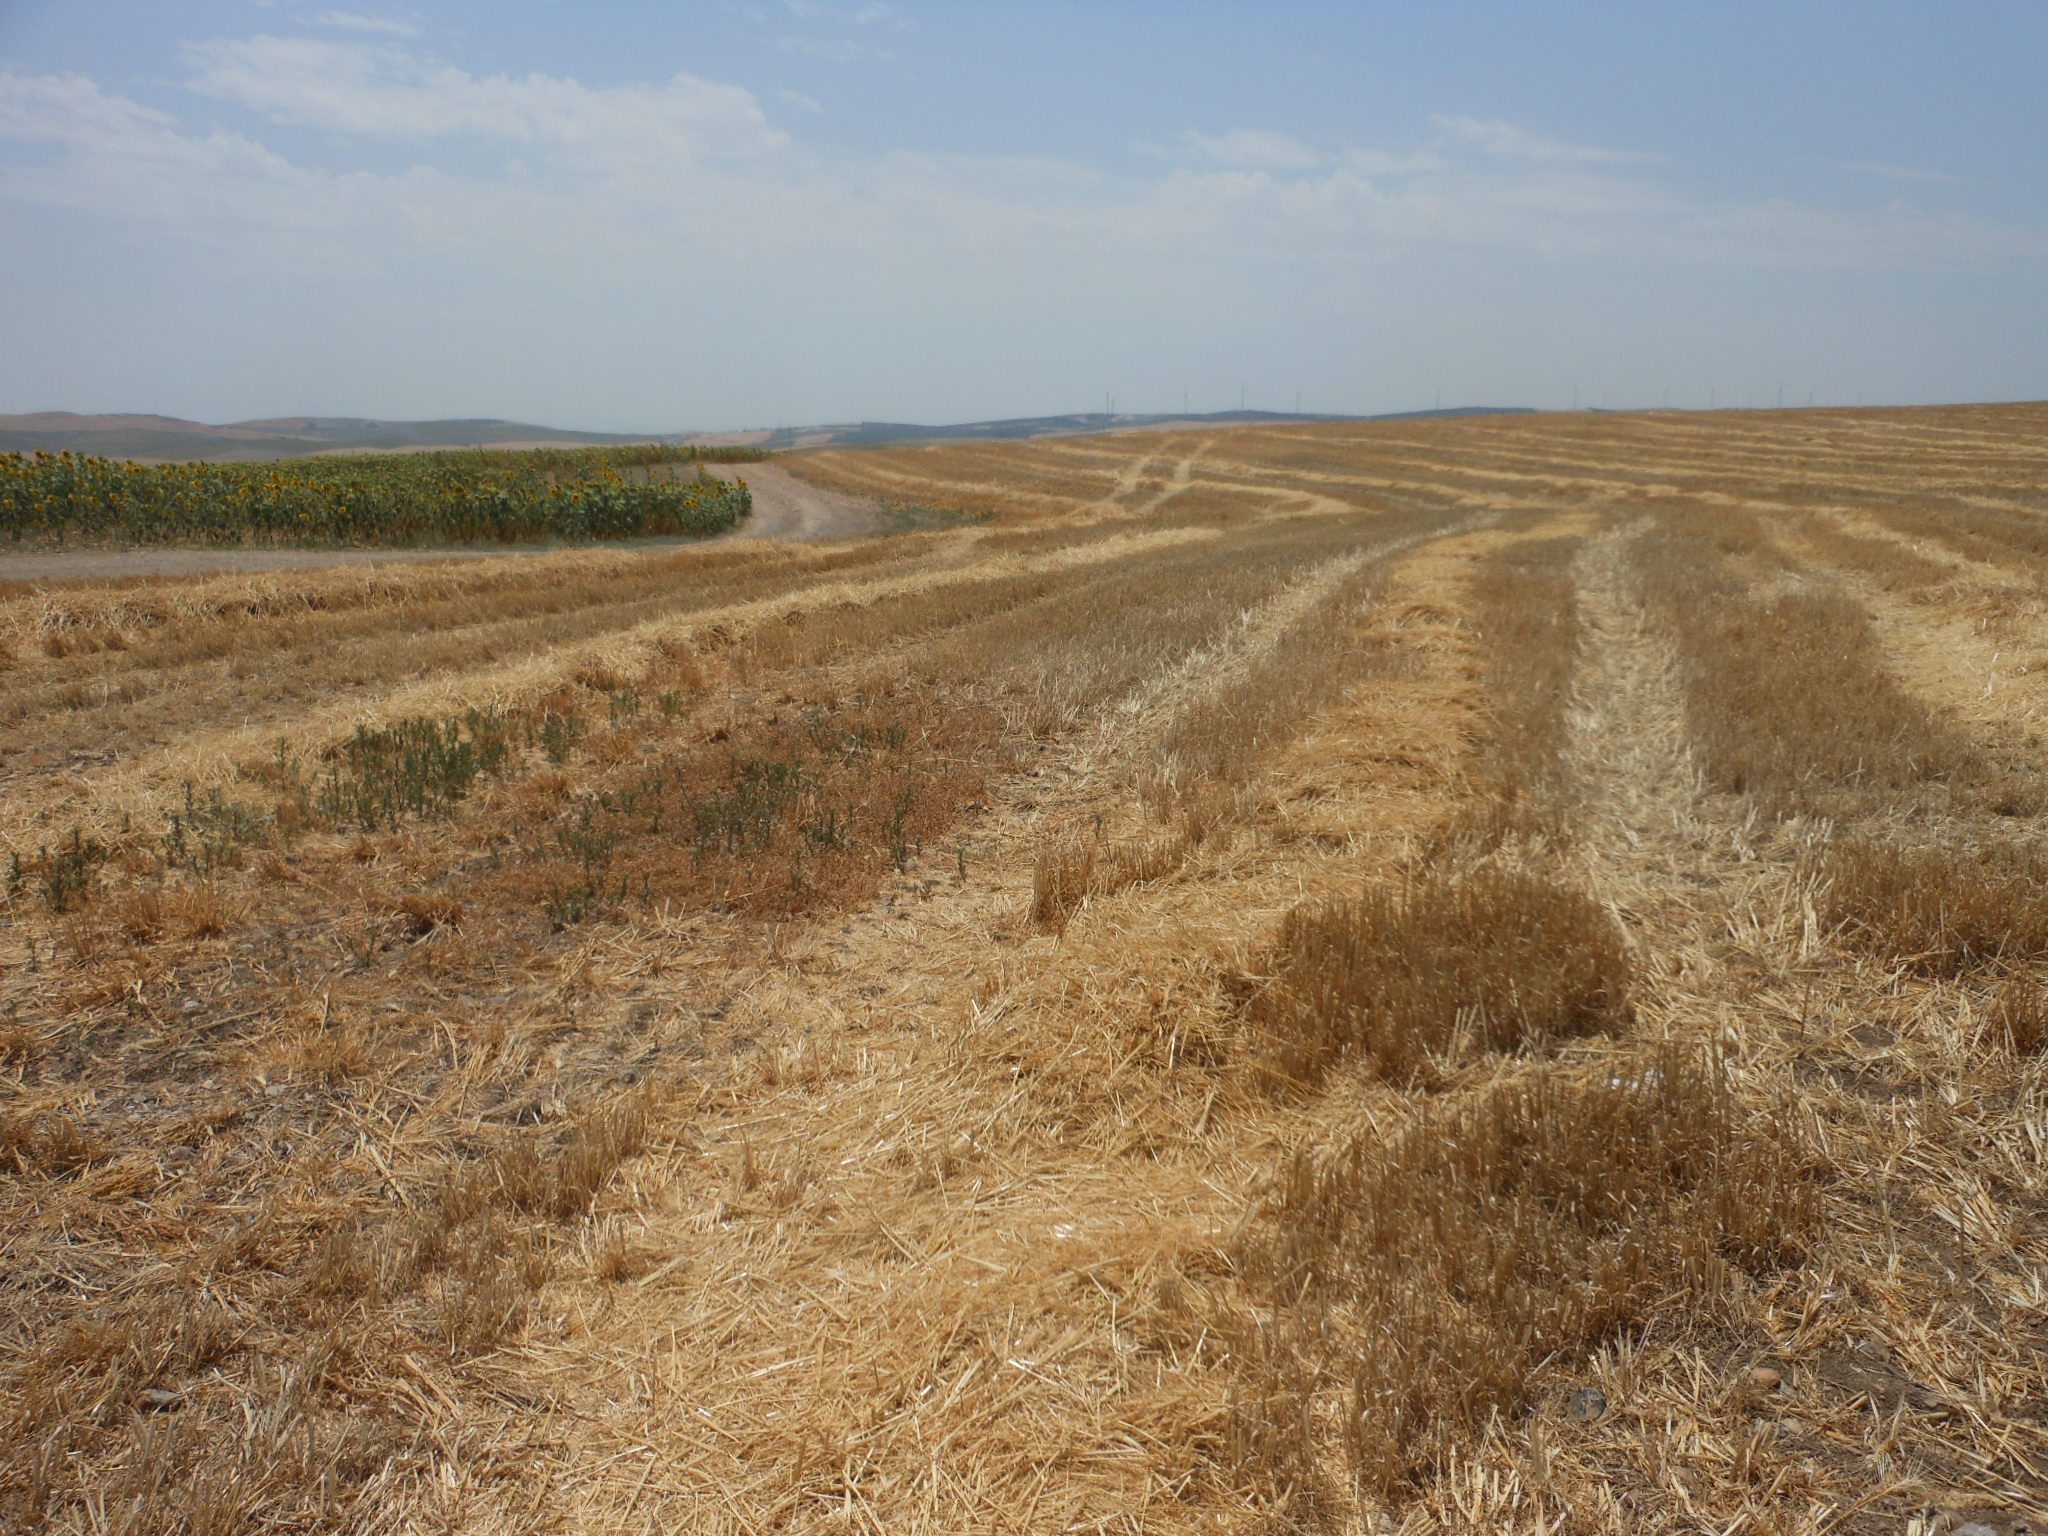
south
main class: Cropland
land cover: Durum wheat
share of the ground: < 10 %
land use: Agriculture (excluding fallow land and kitchen gardens)
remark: Harvested field
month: June
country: ES
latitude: 37.5110
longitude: -5.0927
